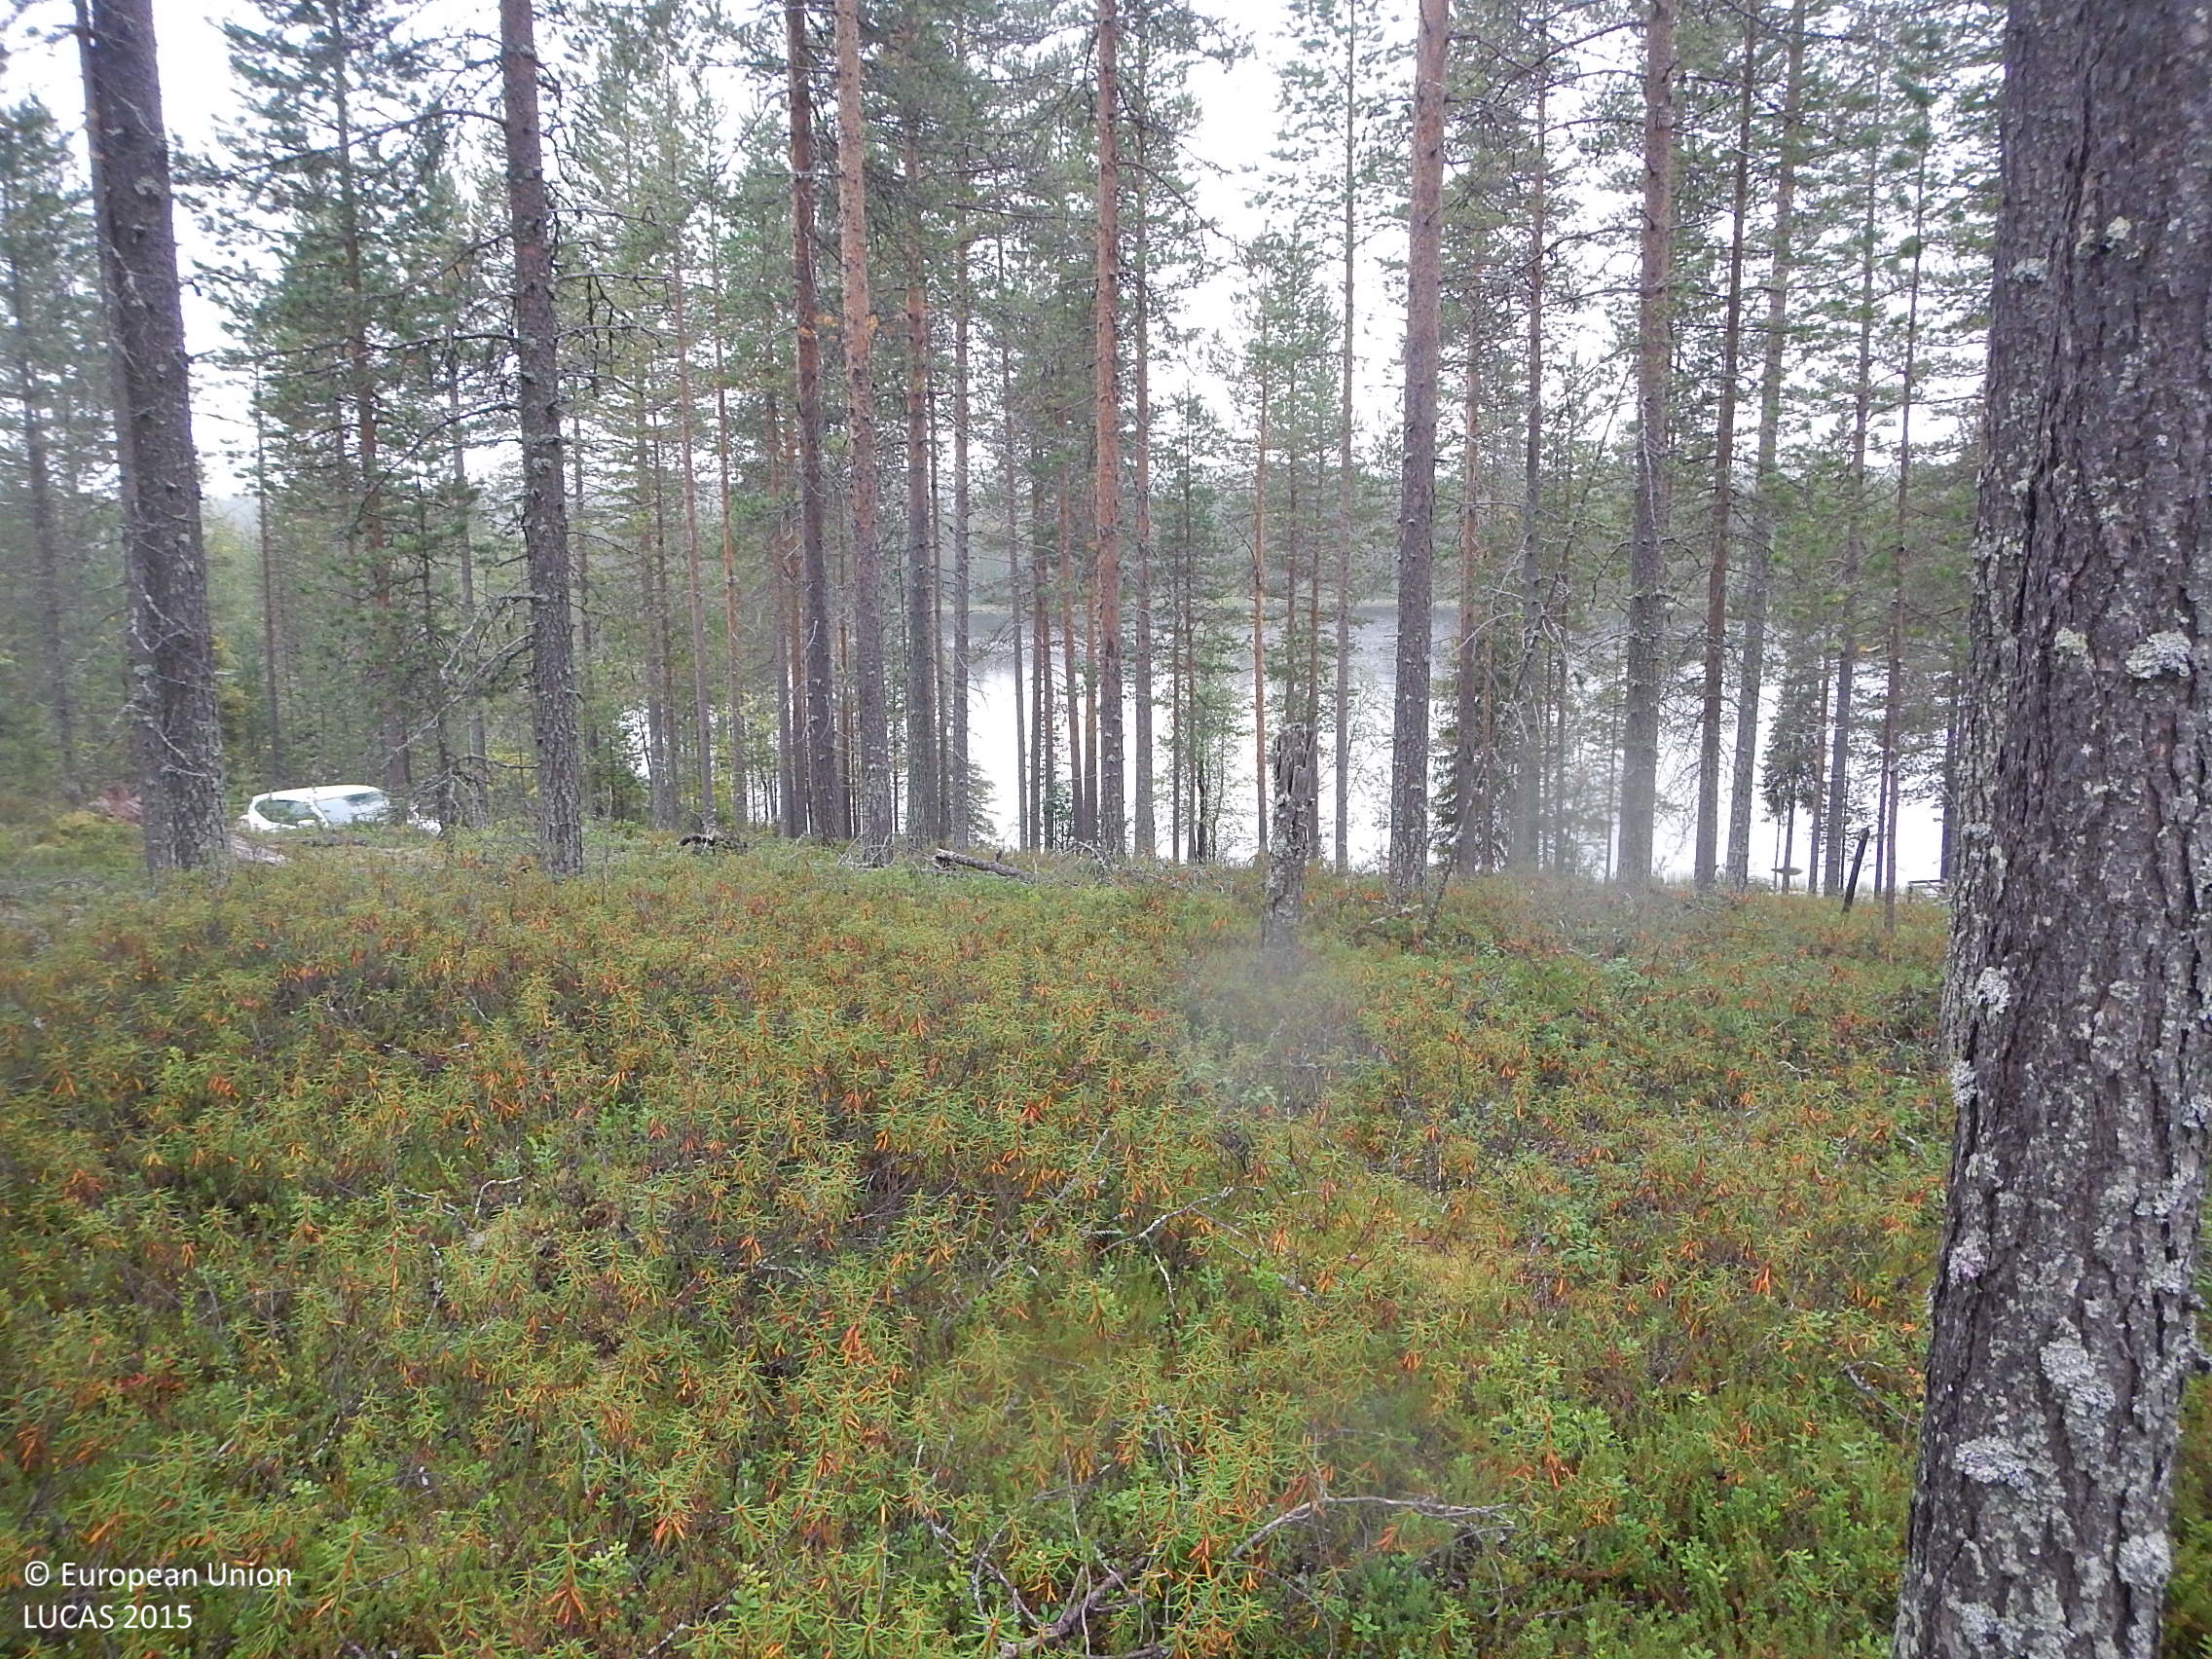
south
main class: Woodland
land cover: Pine dominated coniferous woodland
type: boreal forest
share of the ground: 25 - 50 %
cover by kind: shrubs 65 %, coniferous forest trees 30 %, lichens and mosses 5 %
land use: Forestry
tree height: > 5 m
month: August
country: FI
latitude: 66.0149
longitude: 27.5621
